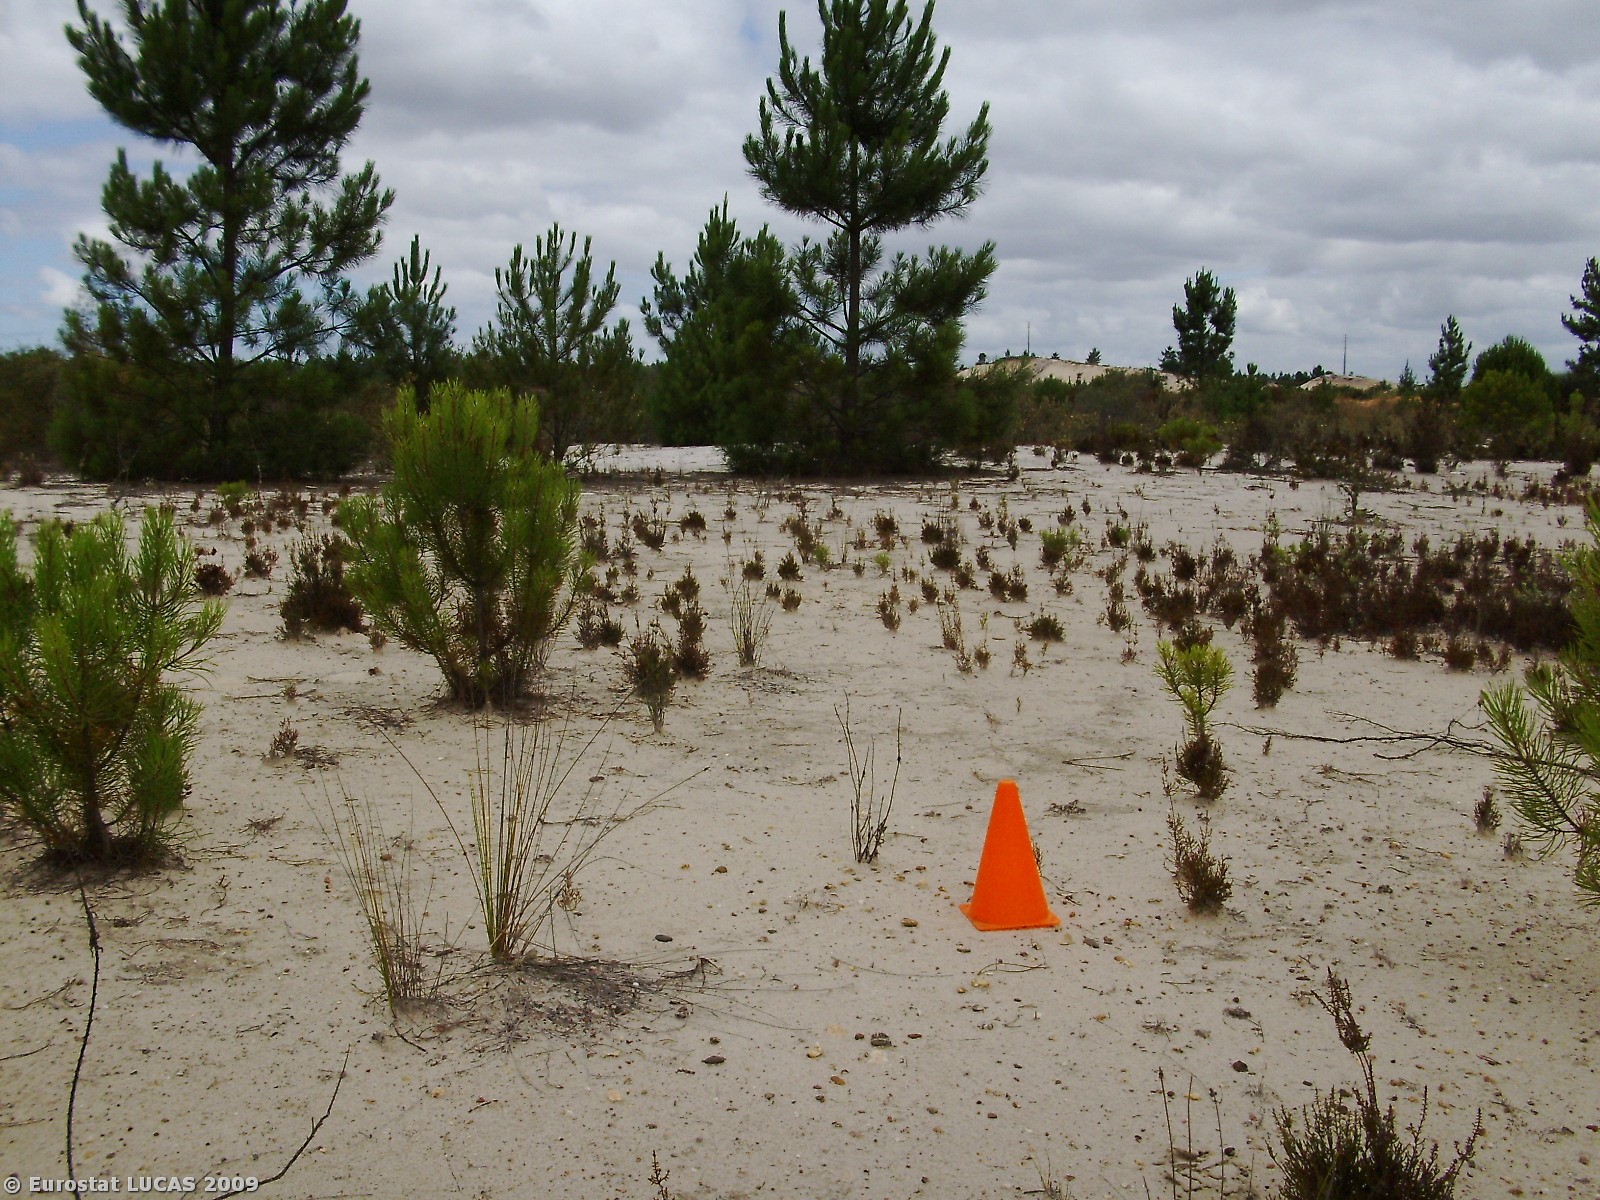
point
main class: Woodland
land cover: Coniferous woodland
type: coniferous forest of the mediterranean region
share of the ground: 25 - 50 %
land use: Forestry
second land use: Mining and quarrying
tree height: > 5 m
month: June
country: PT
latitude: 38.2625
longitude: -8.5296
